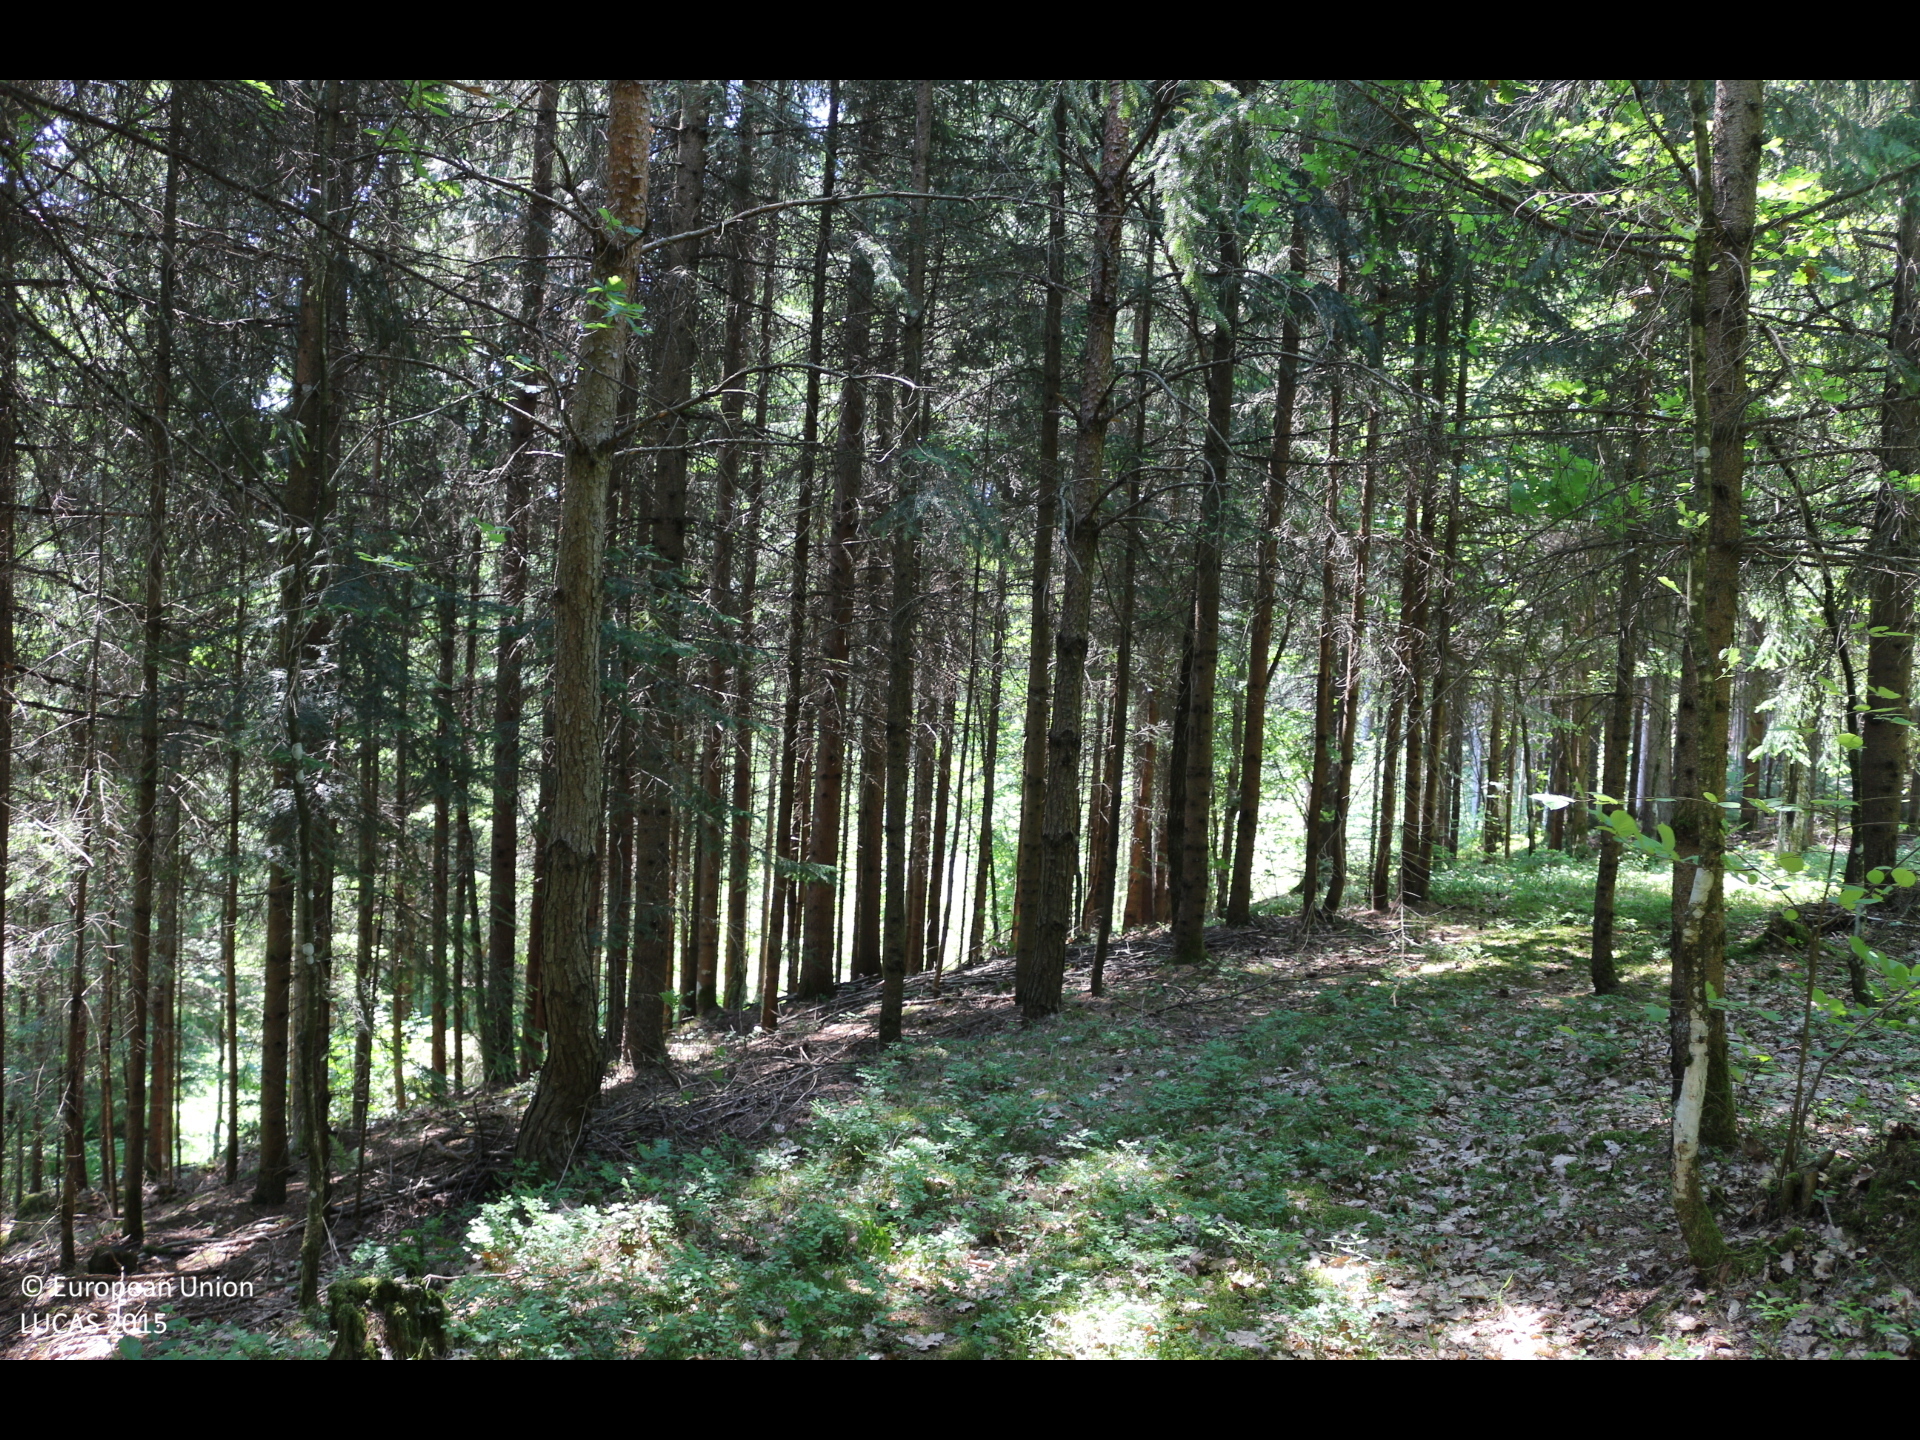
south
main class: Woodland
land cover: Spruce dominated coniferous woodland
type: alpine coniferous forest
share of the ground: > 75 %
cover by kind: coniferous forest trees 90 %, broadleaved forest trees 10 %
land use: Forestry
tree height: > 5 m
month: June
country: AT
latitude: 46.7047
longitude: 14.1175
